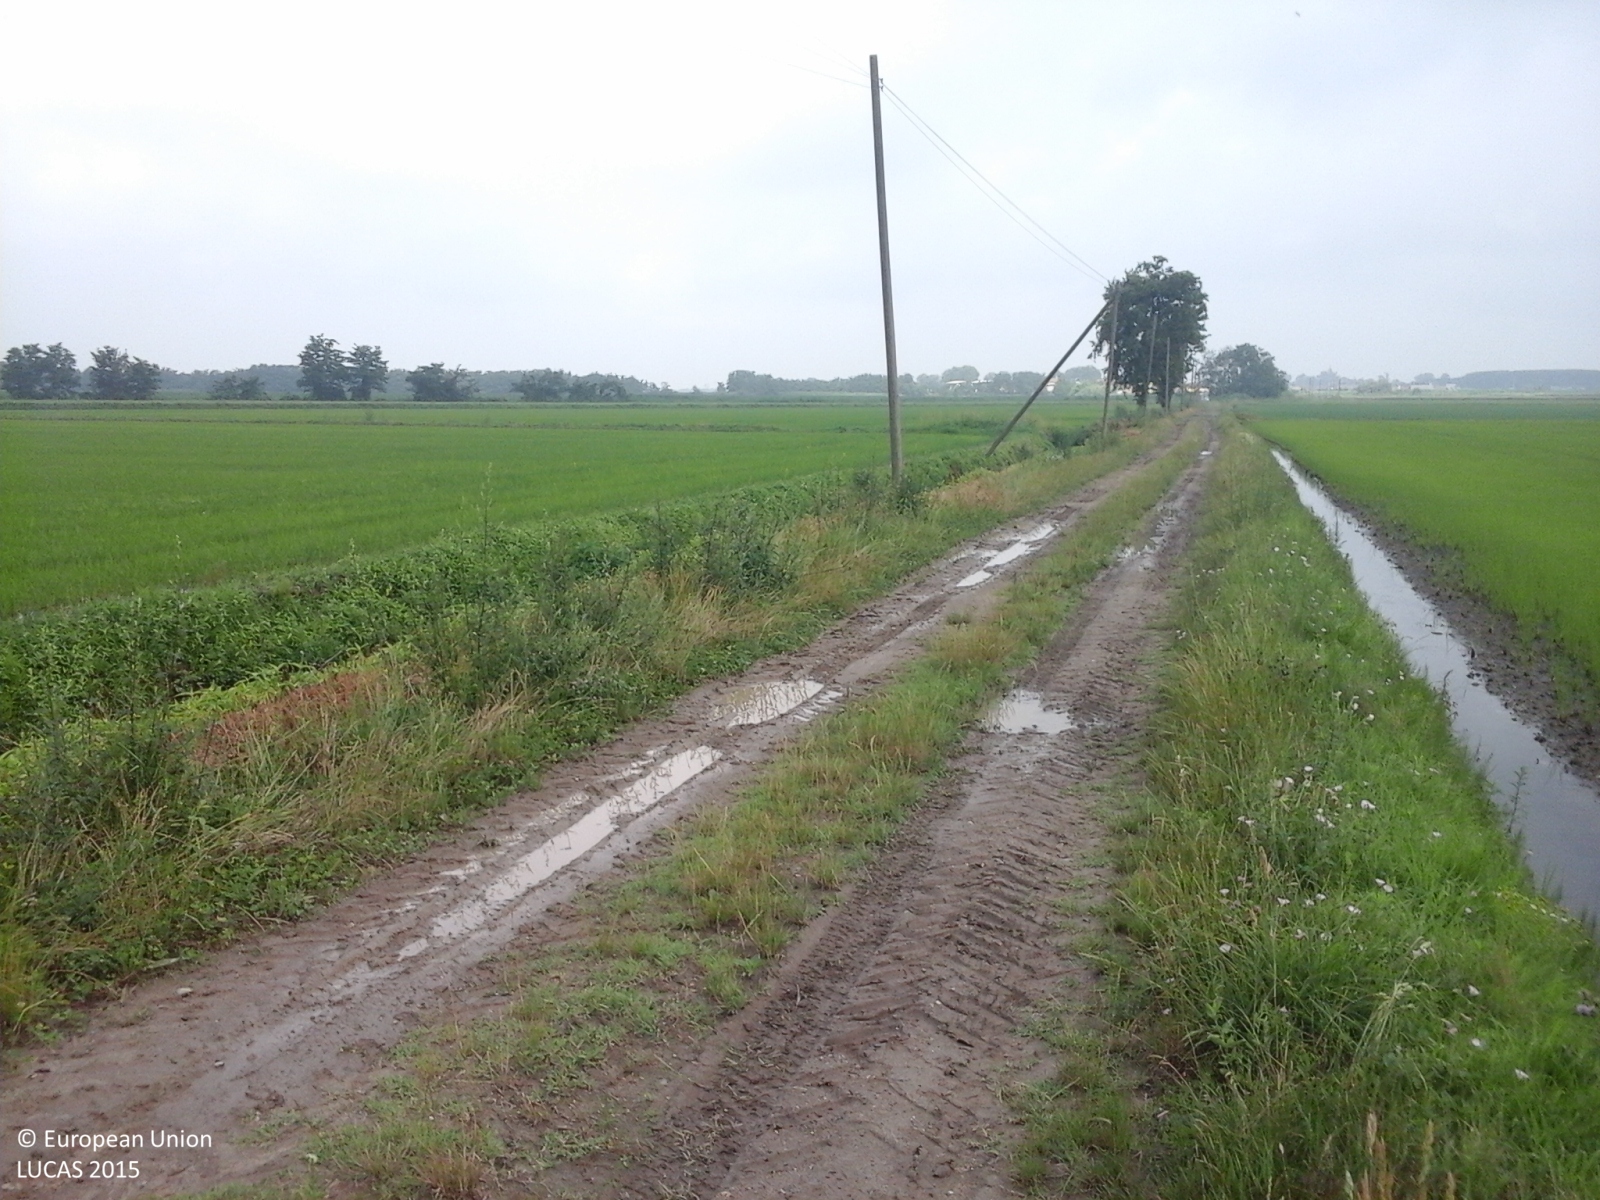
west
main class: Cropland
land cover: Rice
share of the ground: > 75 %
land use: Agriculture (excluding fallow land and kitchen gardens)
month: June
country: IT
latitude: 45.2066
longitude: 8.5893
